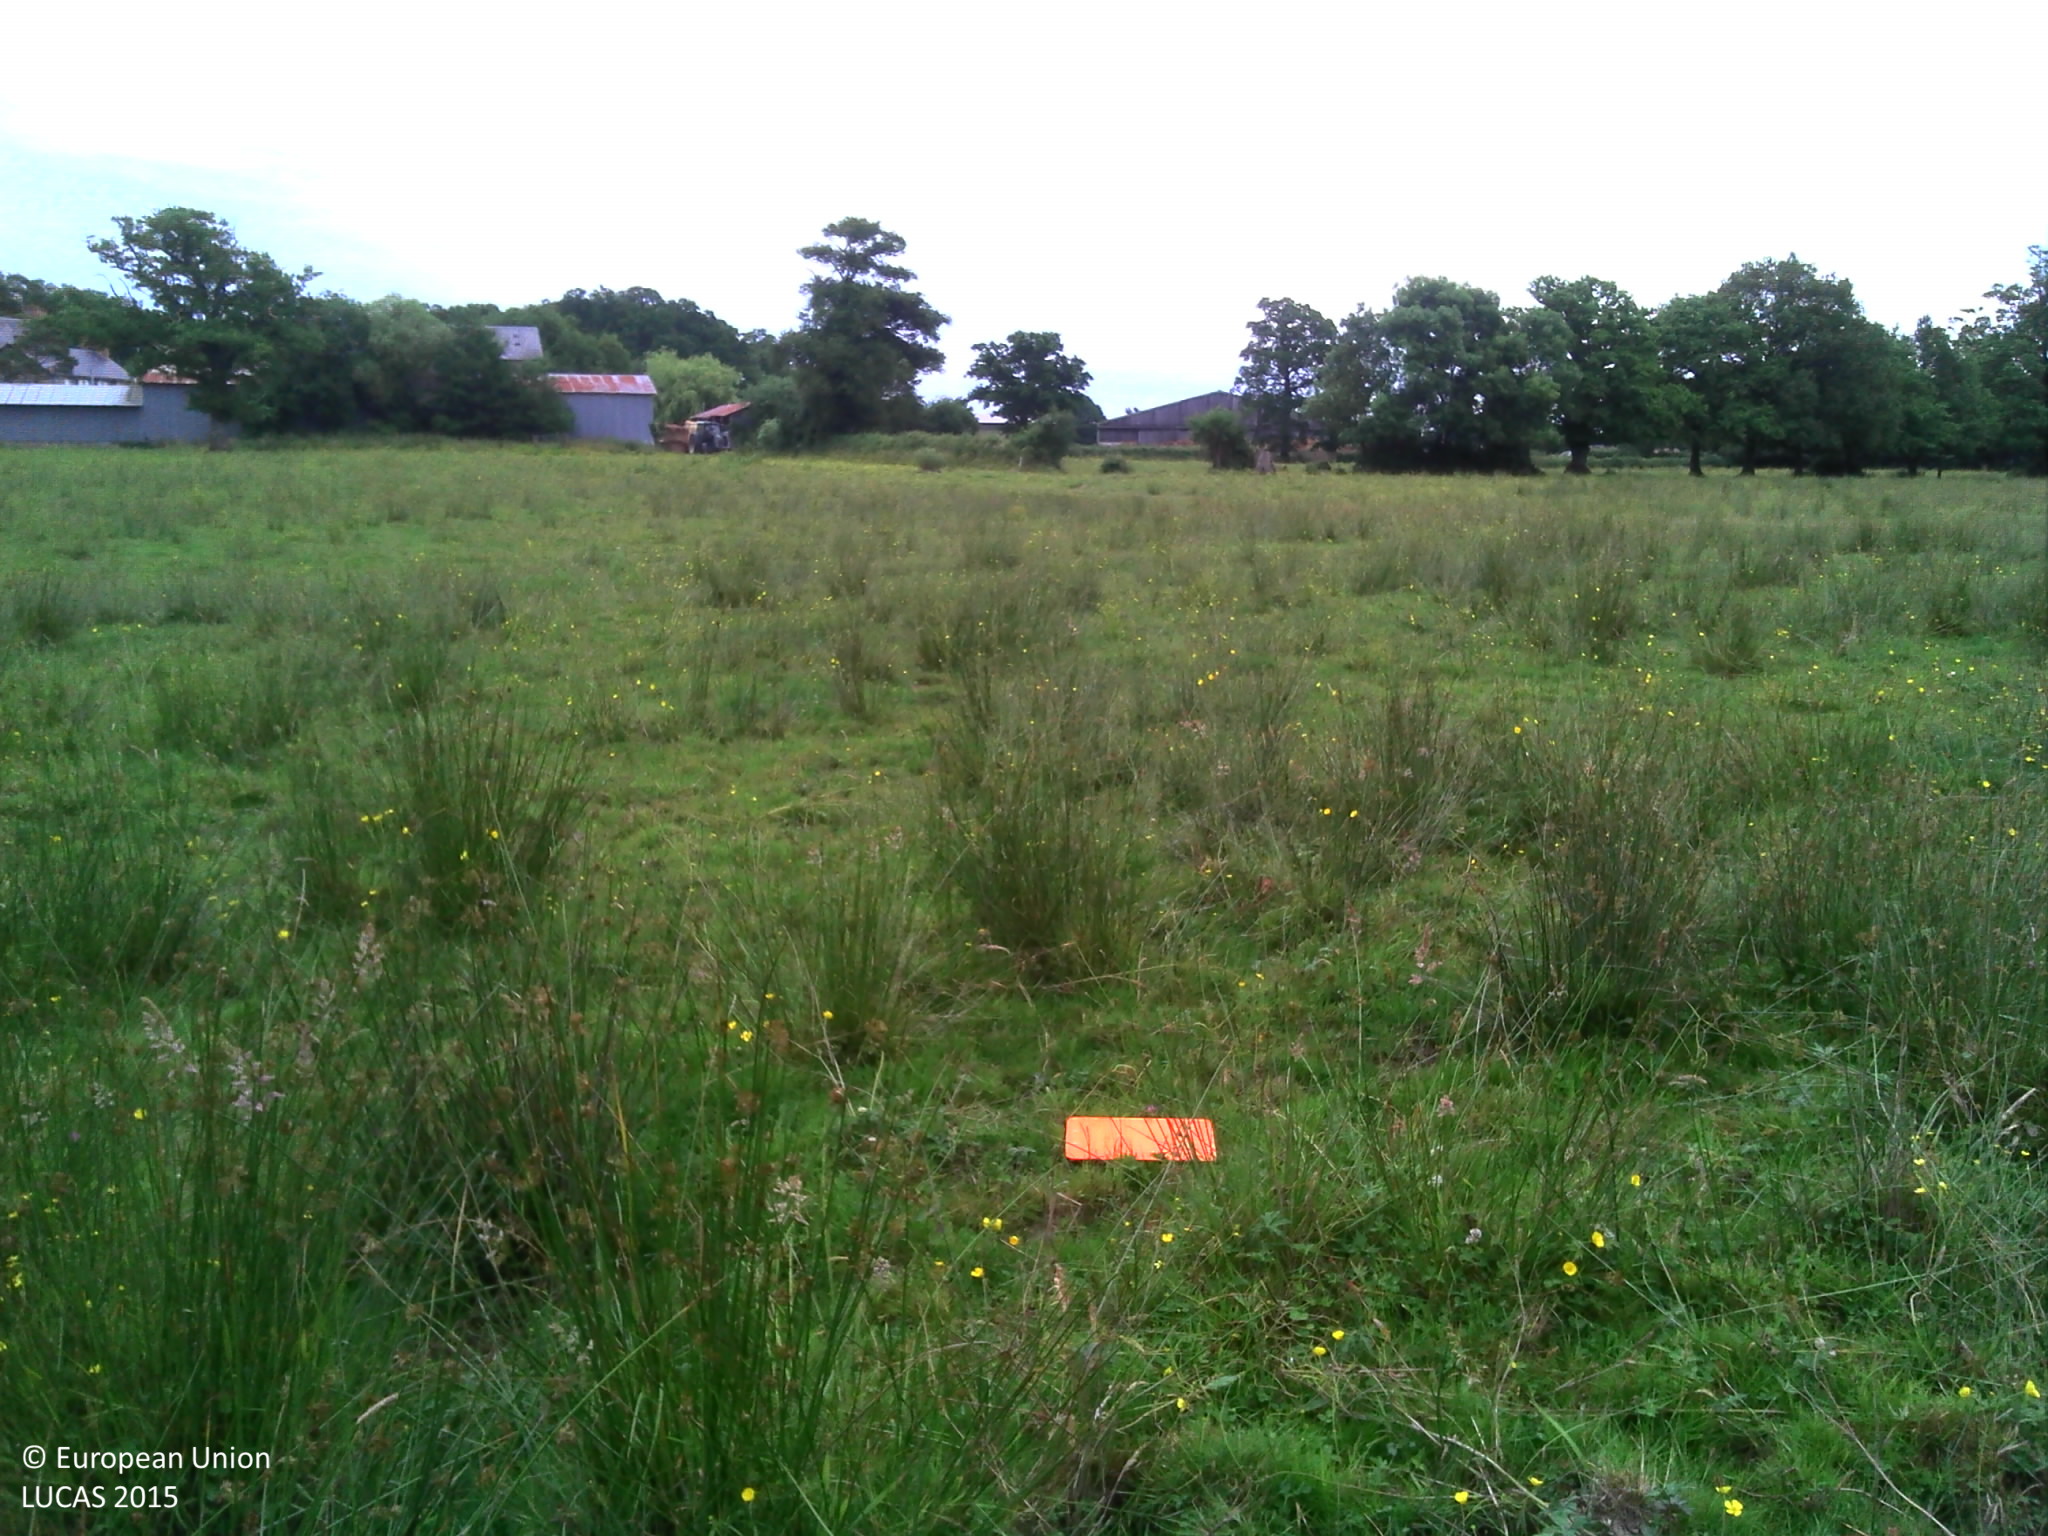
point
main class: Grassland
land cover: Grassland without tree/shrub cover
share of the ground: > 75 %
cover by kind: herbaceous plants 100 %
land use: Agriculture (excluding fallow land and kitchen gardens)
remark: Temporary flooded
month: June
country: FR
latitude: 46.8375
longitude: -1.6717
